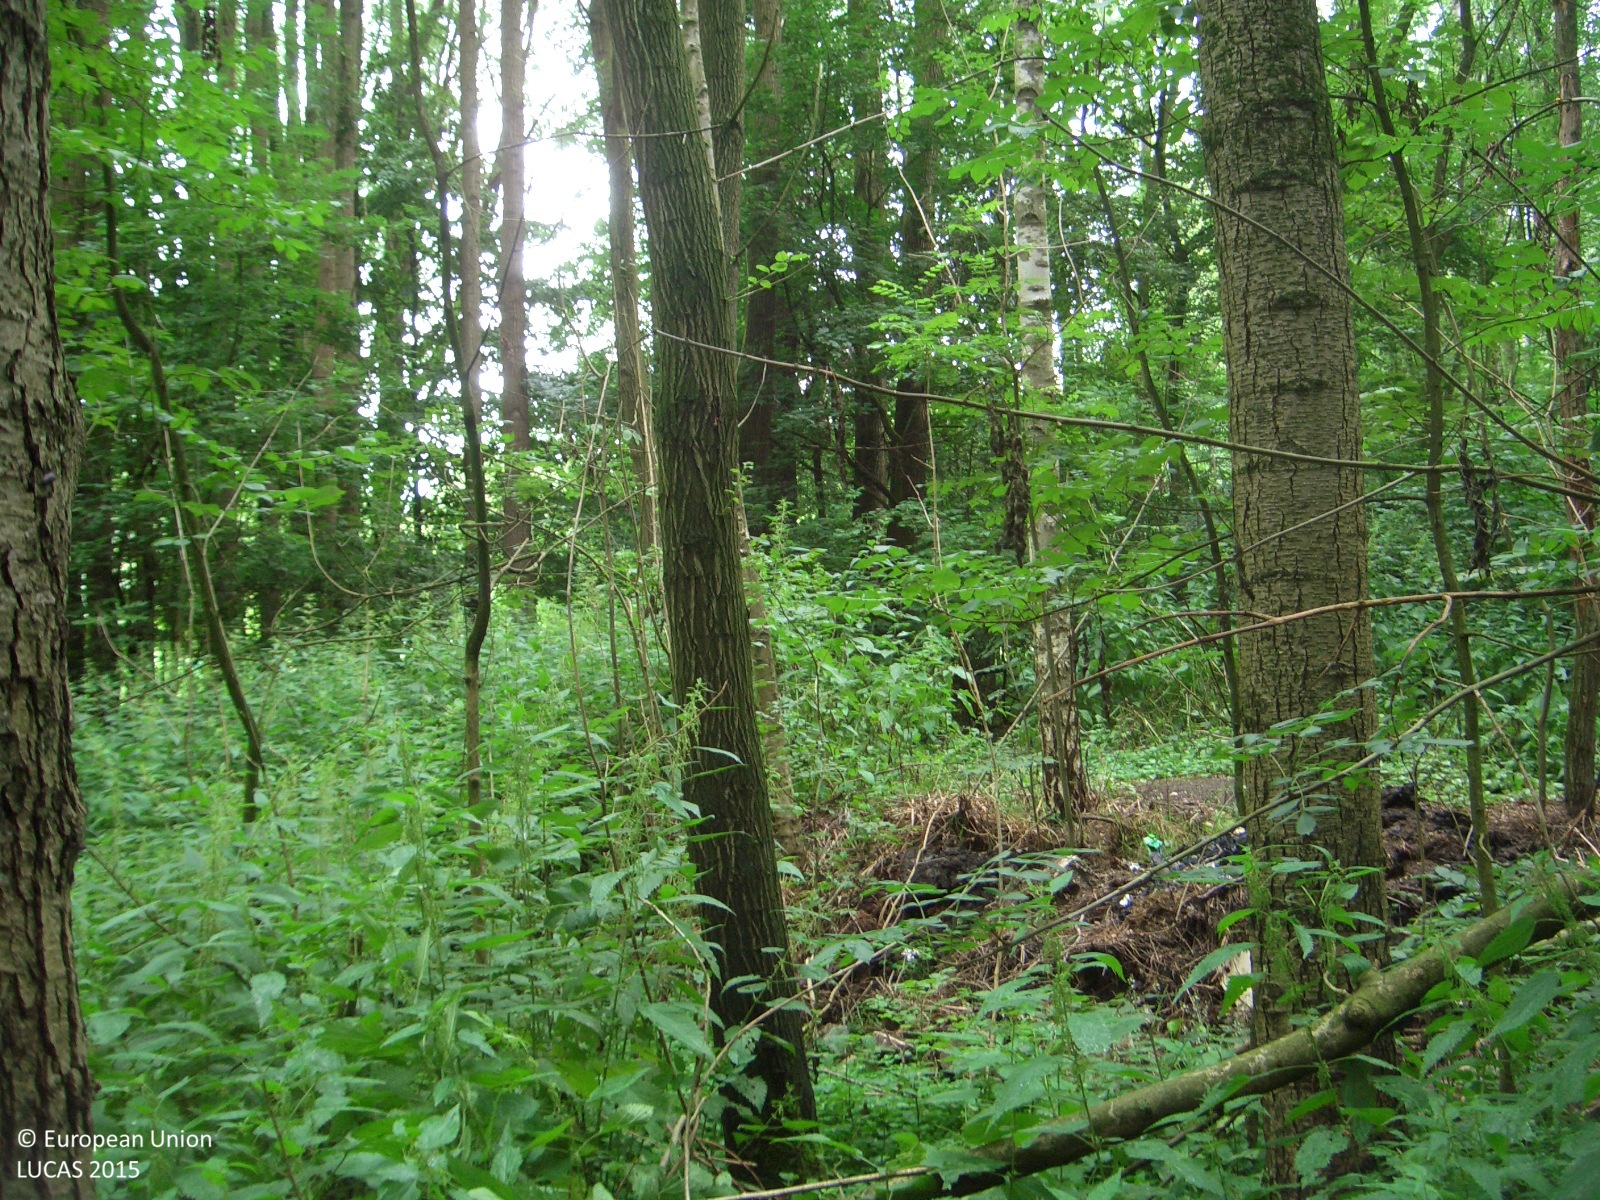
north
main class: Woodland
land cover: Broadleaved woodland
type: mesophytic deciduous forest
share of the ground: > 75 %
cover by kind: broadleaved forest trees 90 %, herbaceous plants 10 %
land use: Forestry
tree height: > 5 m
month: July
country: DE
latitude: 51.5650
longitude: 6.9561
